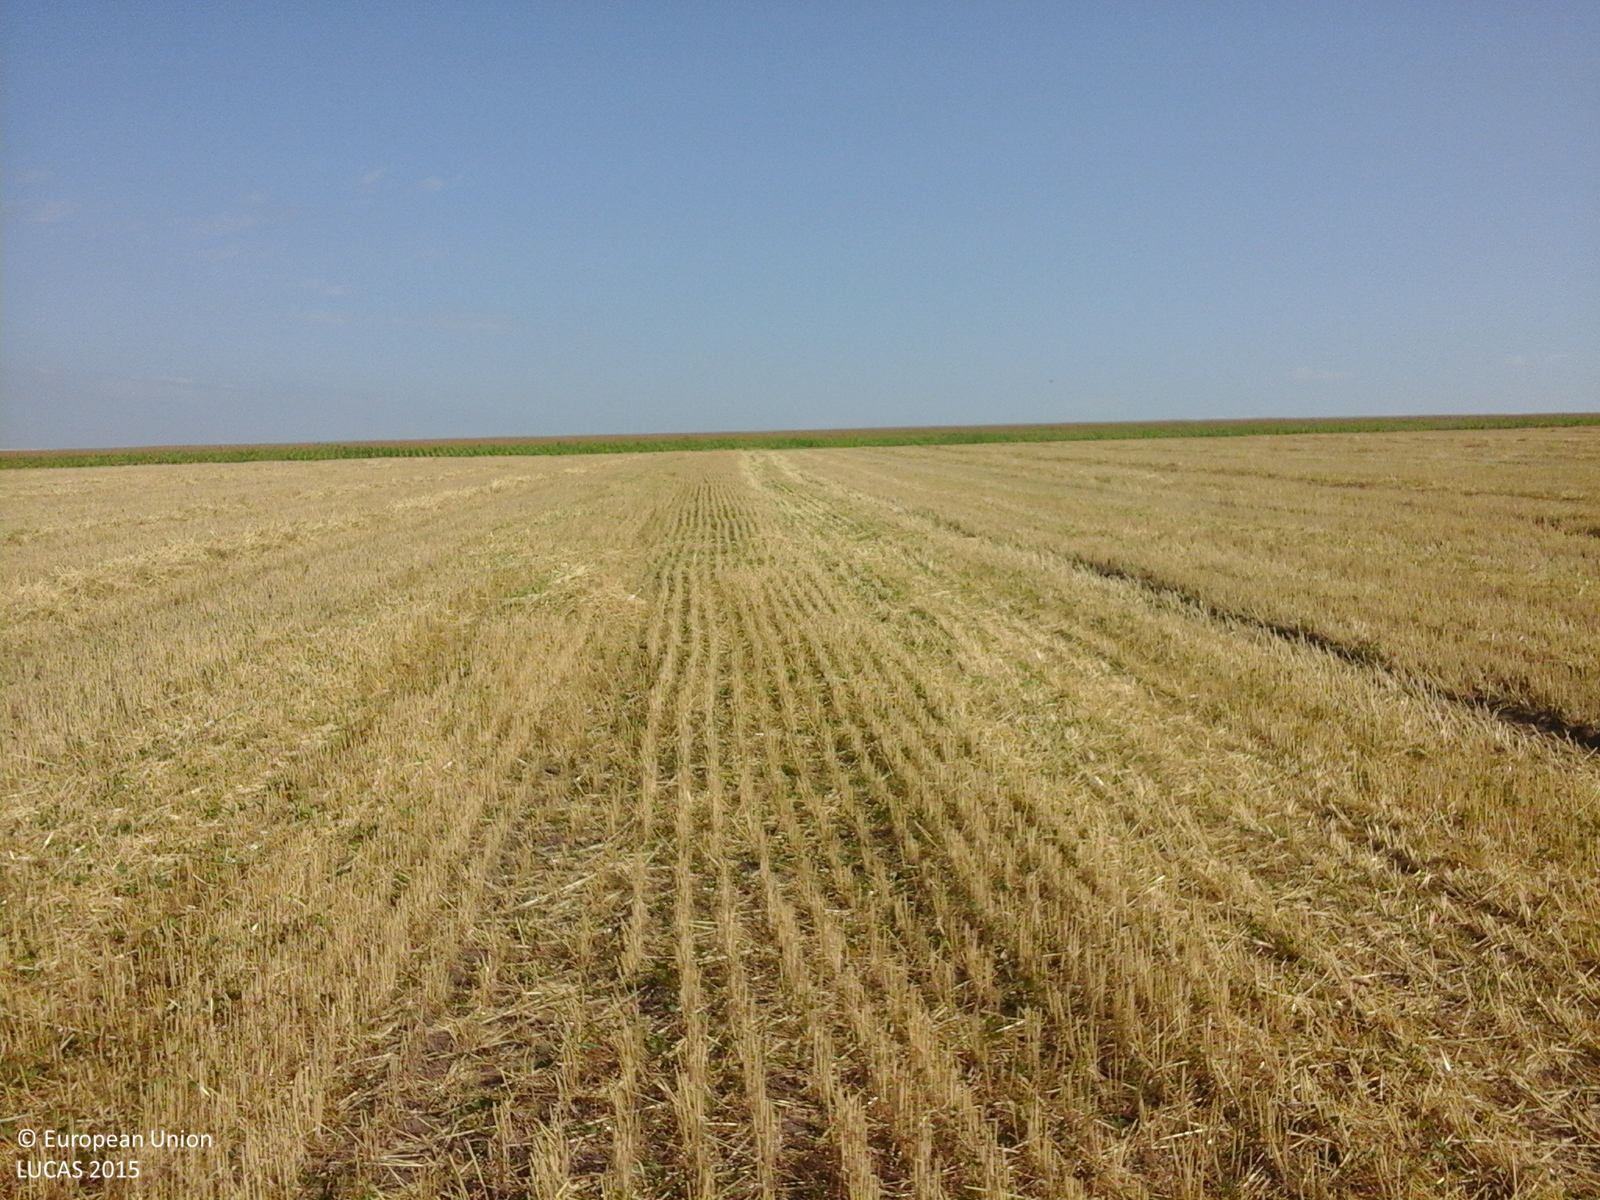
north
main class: Cropland
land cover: Common wheat
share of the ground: > 75 %
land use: Agriculture (excluding fallow land and kitchen gardens)
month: July
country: RO
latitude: 46.3530
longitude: 28.1278
